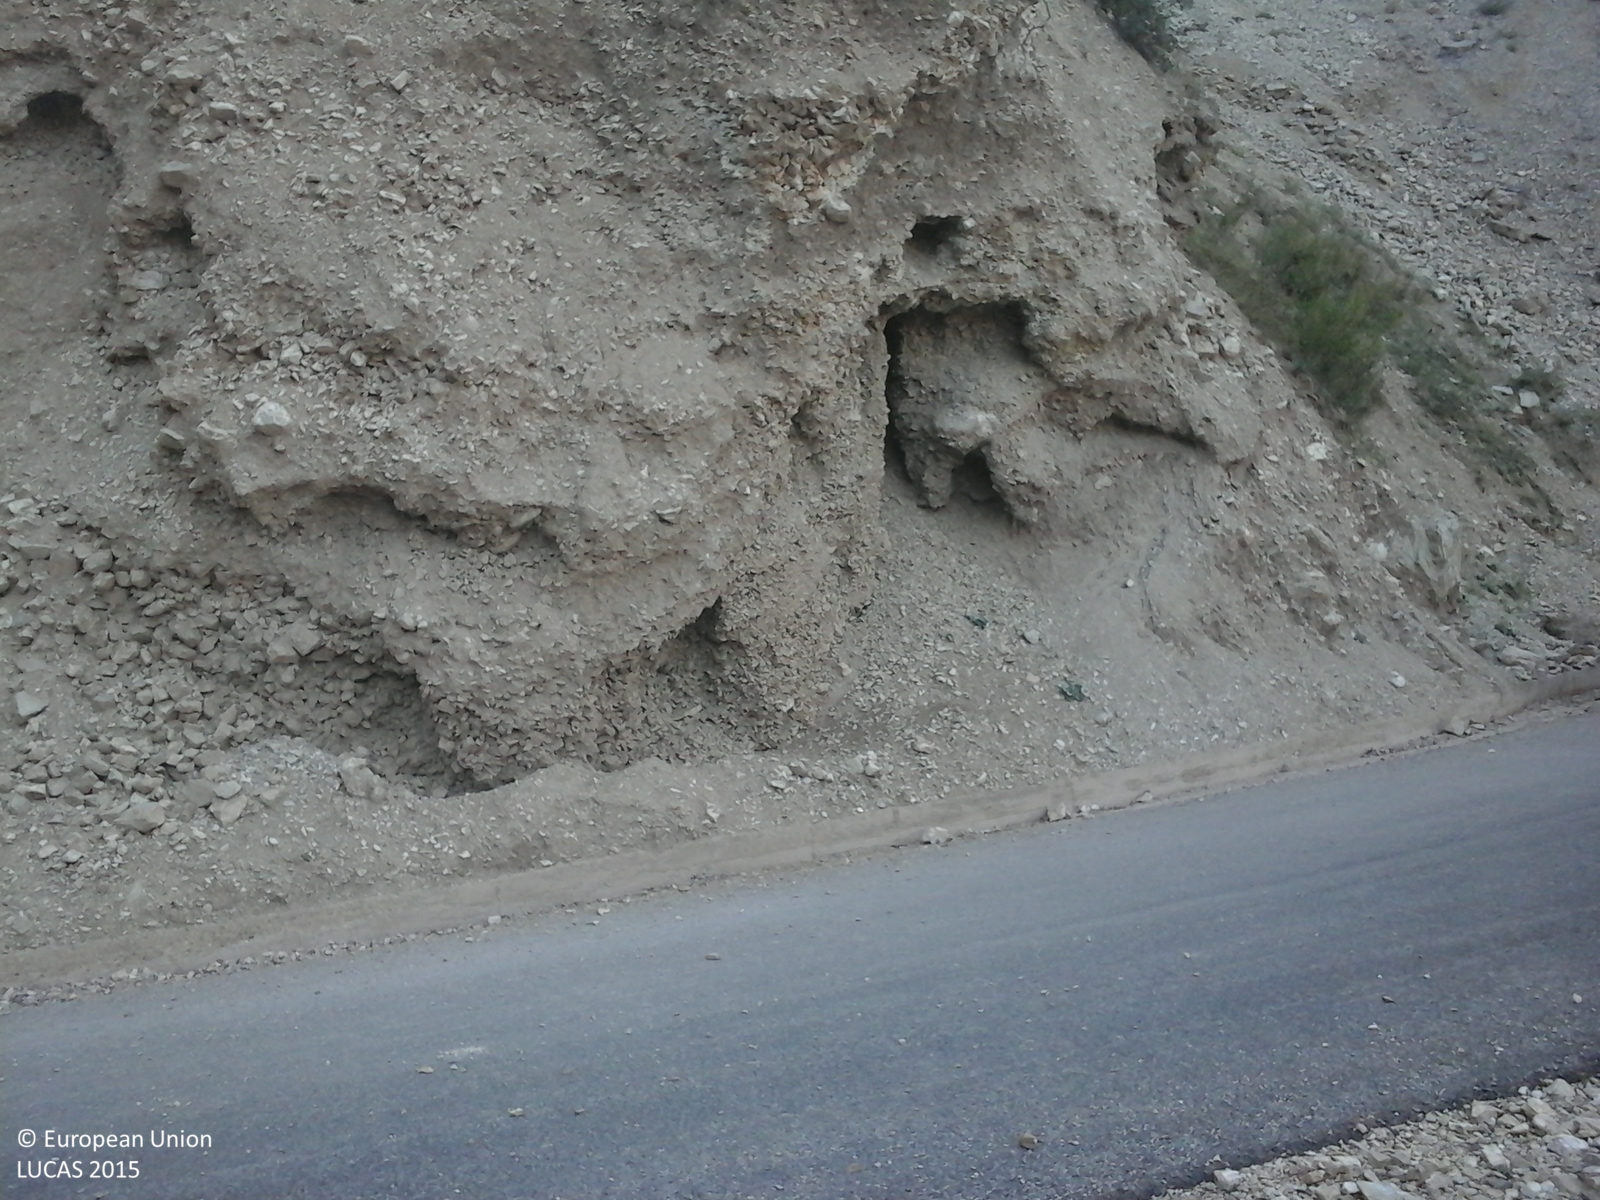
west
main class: Woodland
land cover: Spruce dominated coniferous woodland
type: coniferous forest of the mediterranean region
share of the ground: > 75 %
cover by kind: coniferous forest trees 75 %, unconsolidated bare surface 25 %
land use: Semi-natural and natural areas not in use
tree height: > 5 m
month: August
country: GR
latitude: 38.7428
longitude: 21.6970
